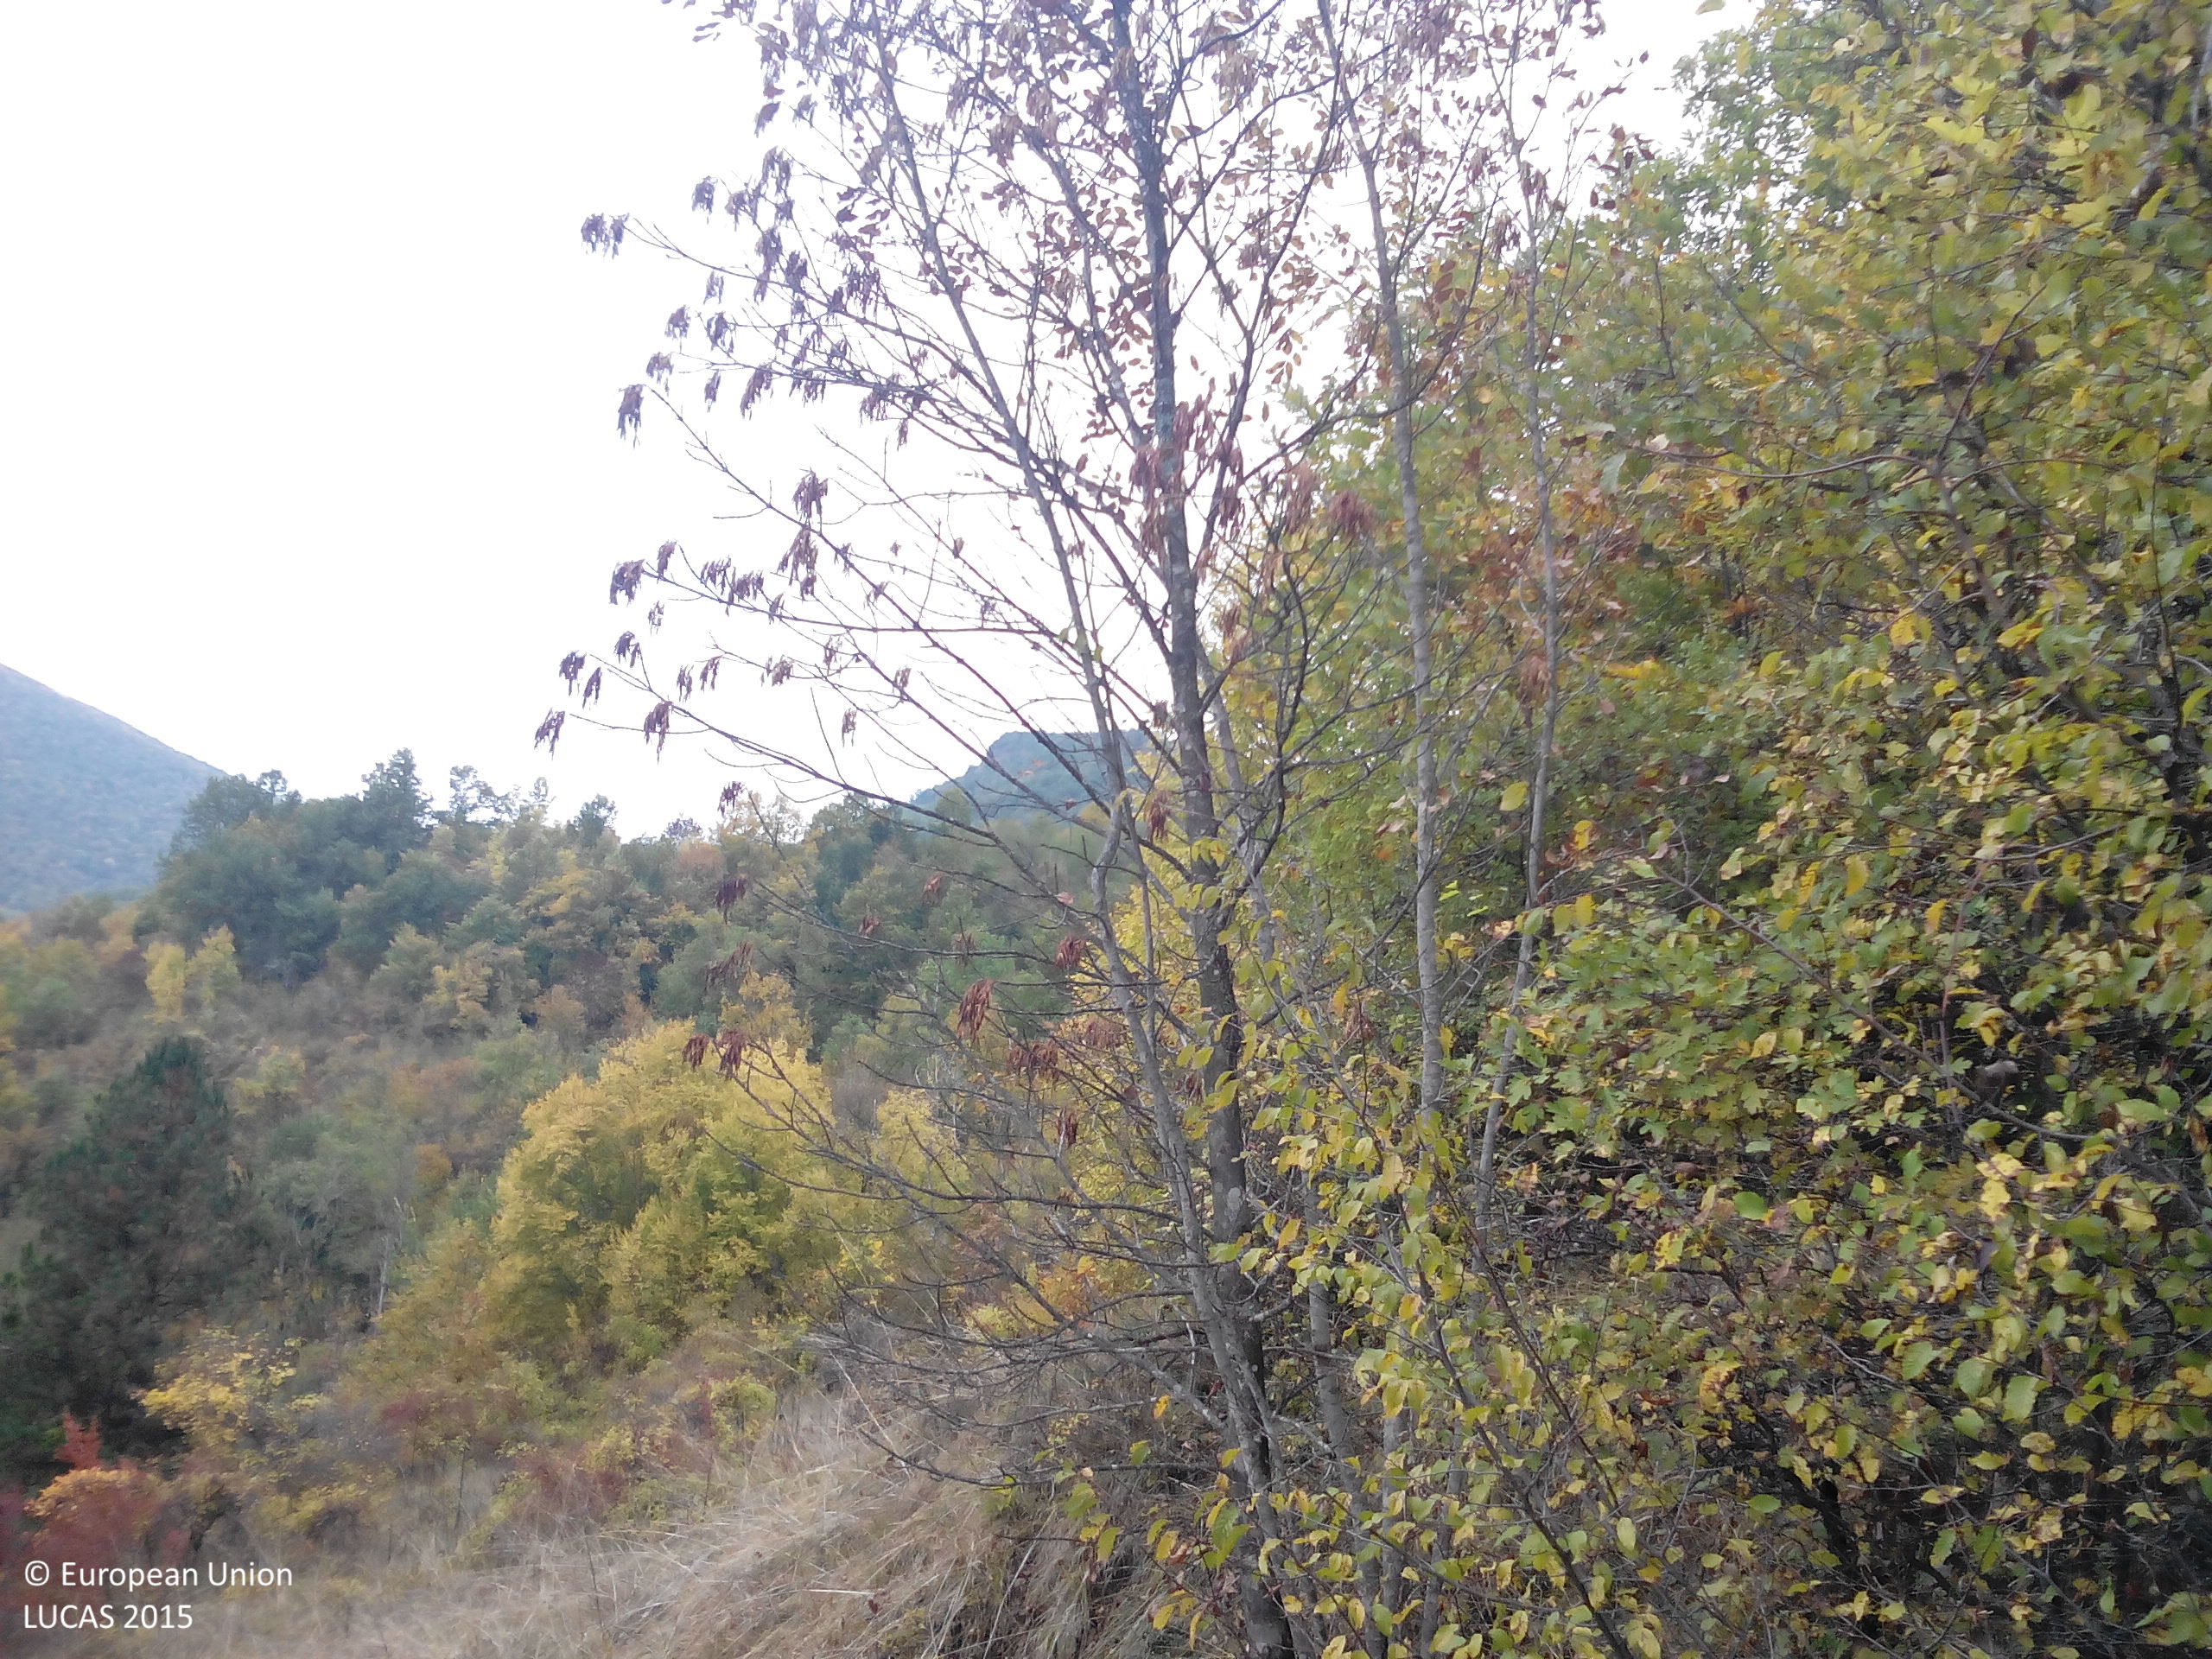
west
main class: Woodland
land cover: Broadleaved woodland
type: mesophytic deciduous forest
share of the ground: > 75 %
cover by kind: broadleaved forest trees 90 %, shrubs 5 %, herbaceous plants 5 %
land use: Semi-natural and natural areas not in use
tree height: > 5 m
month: October
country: BG
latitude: 42.9935
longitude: 23.8688
